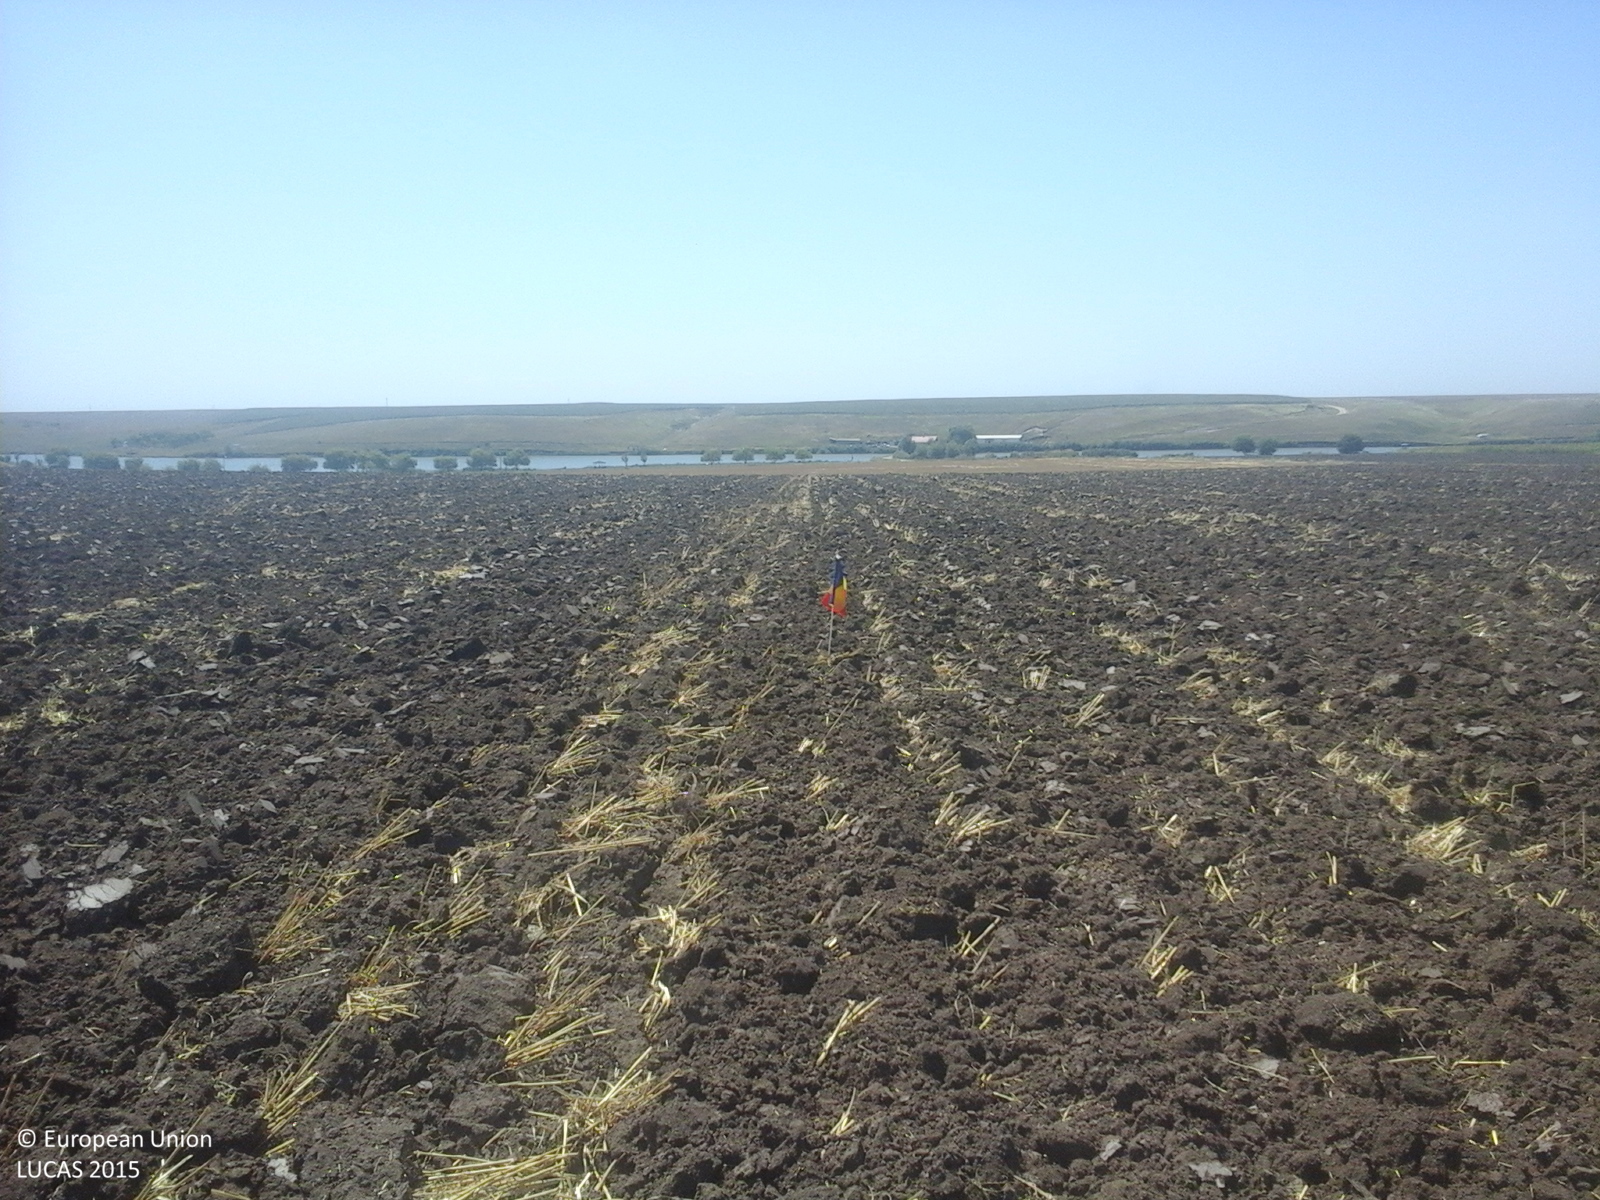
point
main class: Cropland
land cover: Durum wheat
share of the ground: < 10 %
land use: Agriculture (excluding fallow land and kitchen gardens)
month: July
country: RO
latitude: 44.4395
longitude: 26.6919
